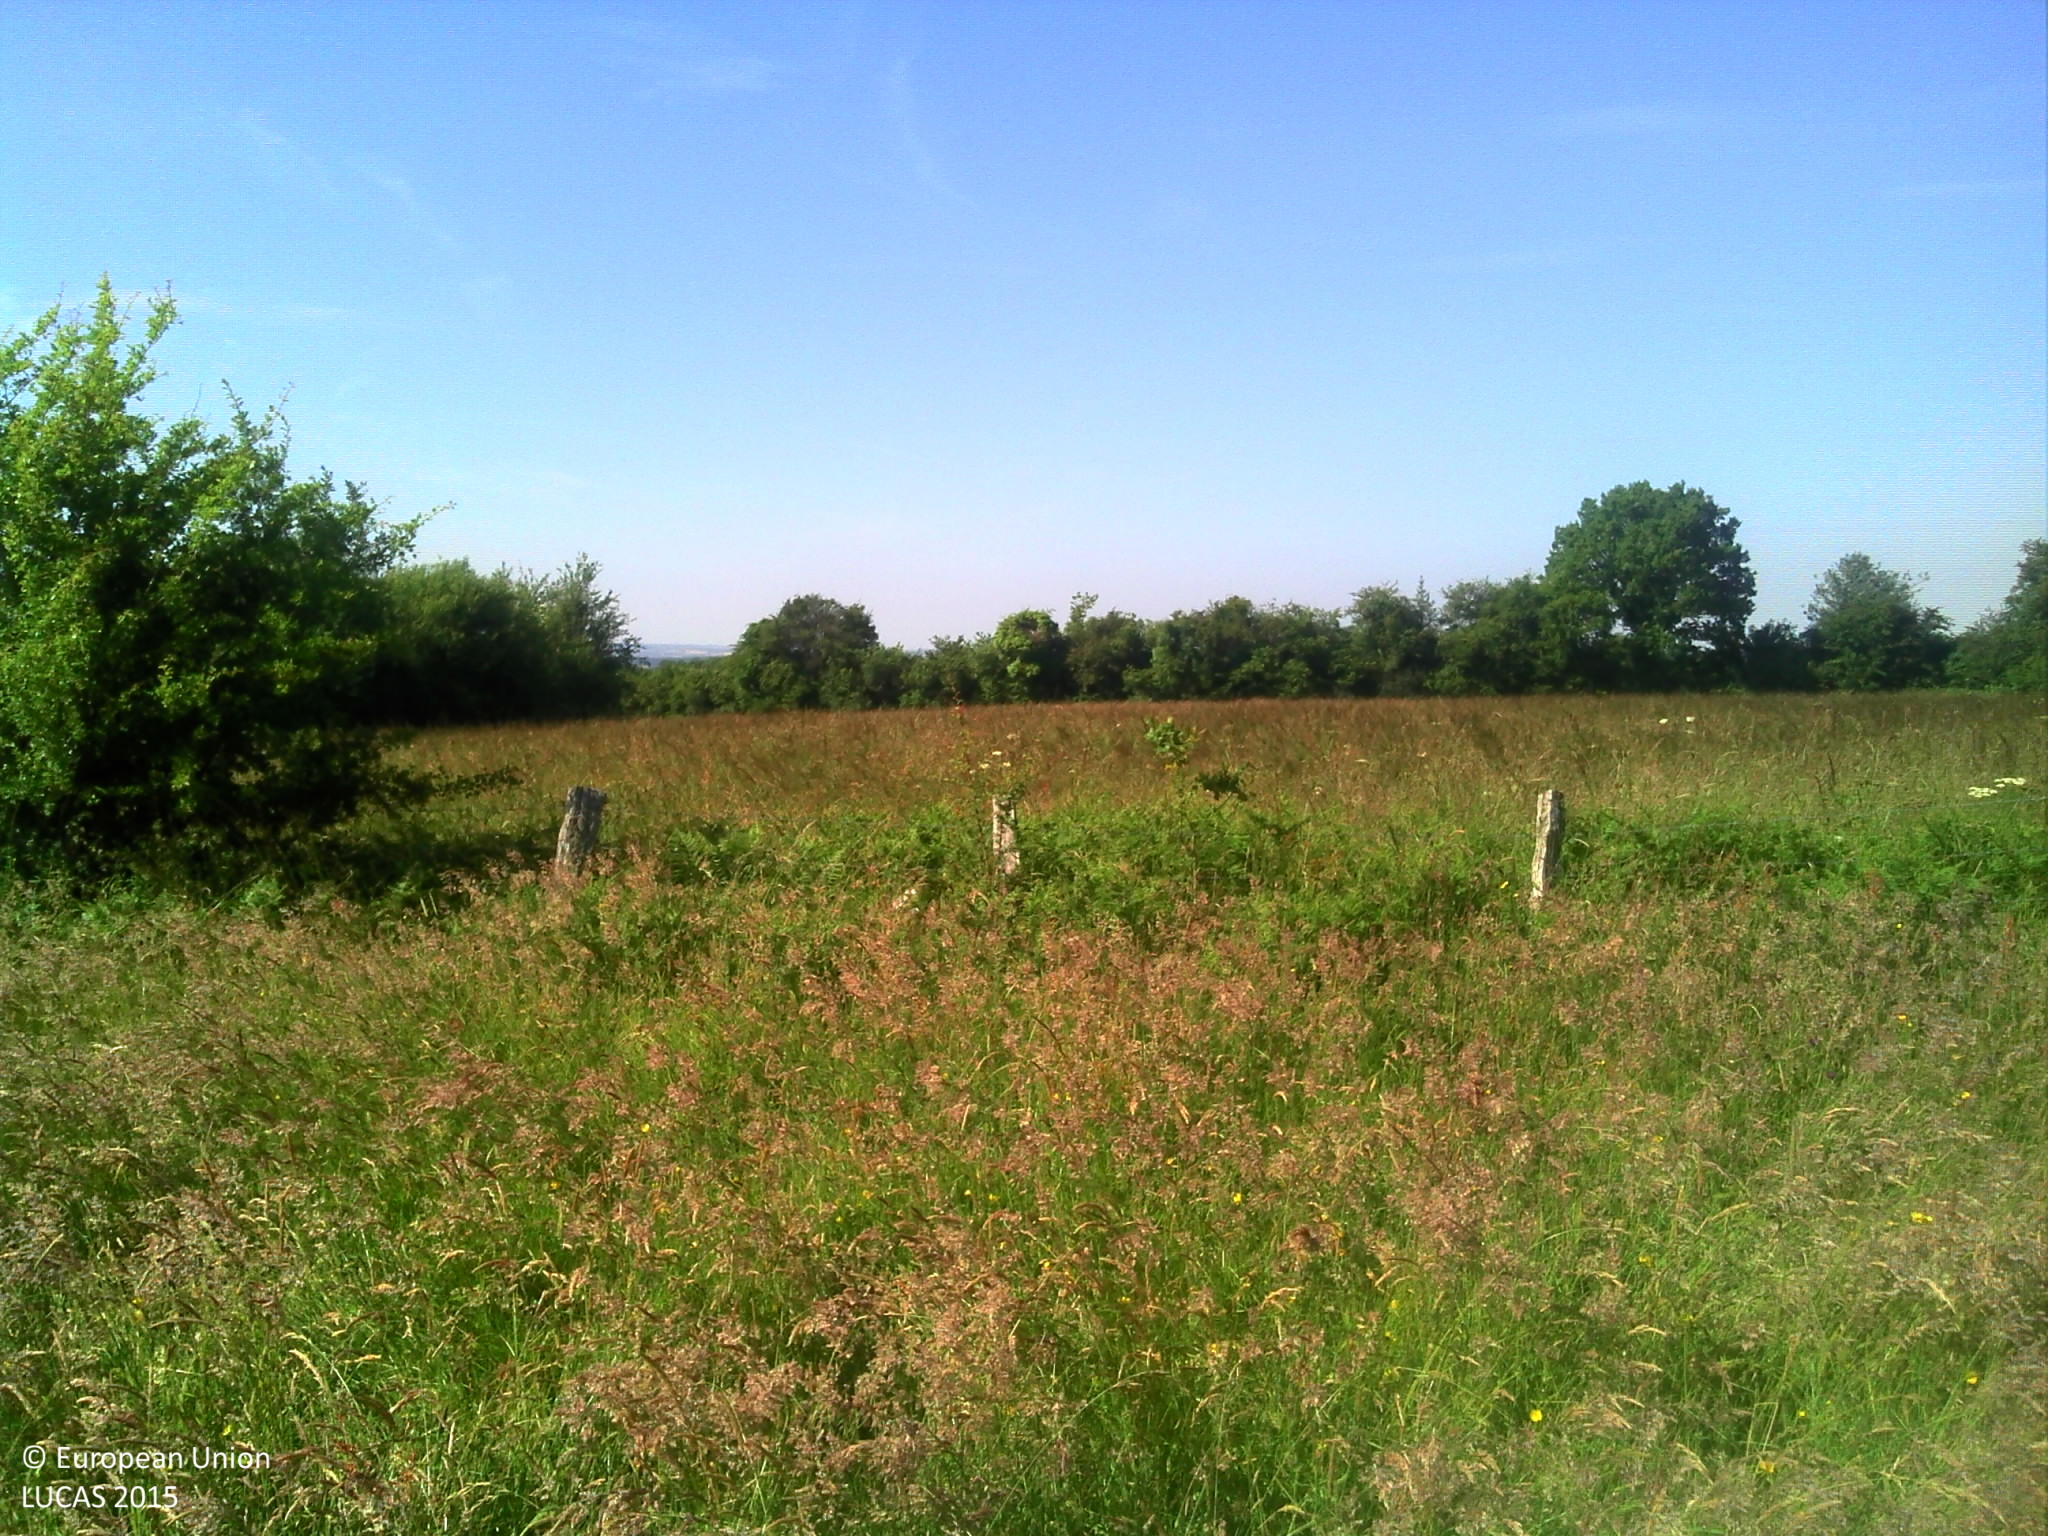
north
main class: Grassland
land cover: Grassland without tree/shrub cover
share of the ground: > 75 %
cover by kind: herbaceous plants 100 %
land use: Agriculture (excluding fallow land and kitchen gardens)
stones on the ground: < 10 %
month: June
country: FR
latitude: 48.5921
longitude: -0.1047
